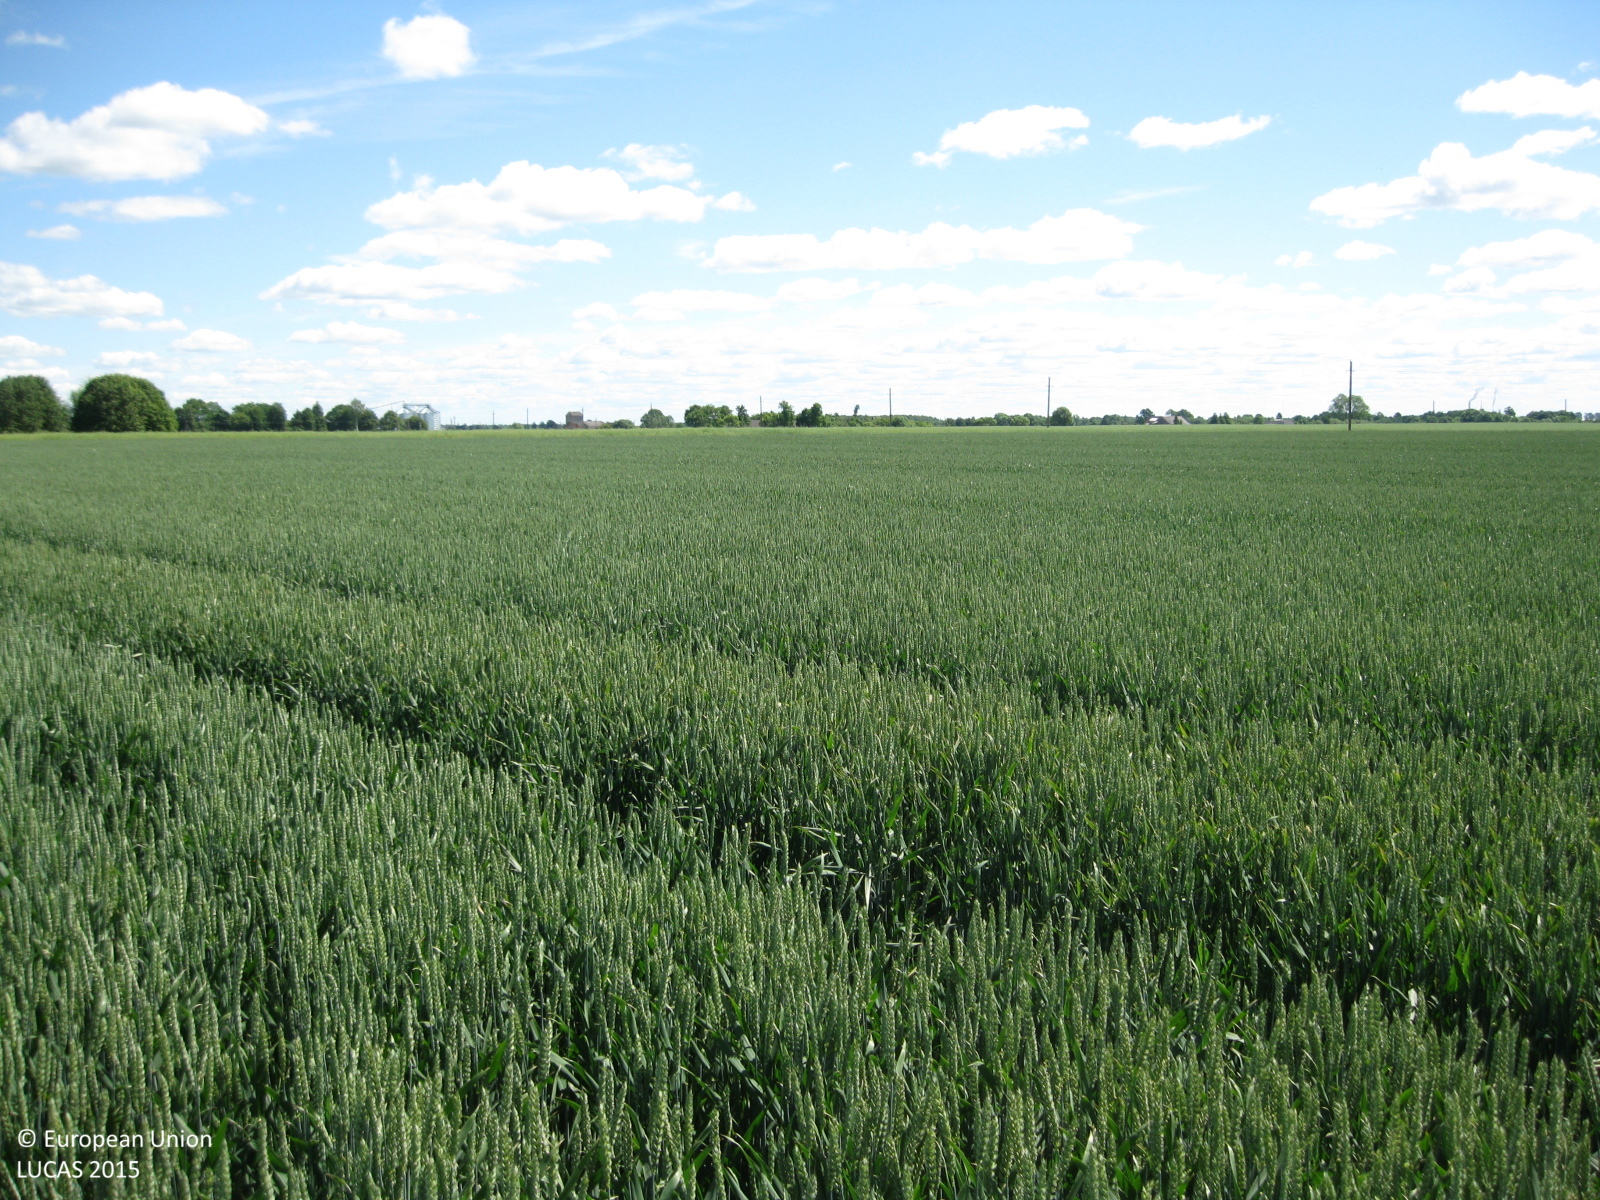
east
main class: Cropland
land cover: Common wheat
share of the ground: > 75 %
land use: Agriculture (excluding fallow land and kitchen gardens)
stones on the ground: < 10 %
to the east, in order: Common wheat; Grass margins; Paved roads, cycling and walking lanes; Grass margins; Rape and turnip rape
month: June
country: LT
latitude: 55.3157
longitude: 23.9068
